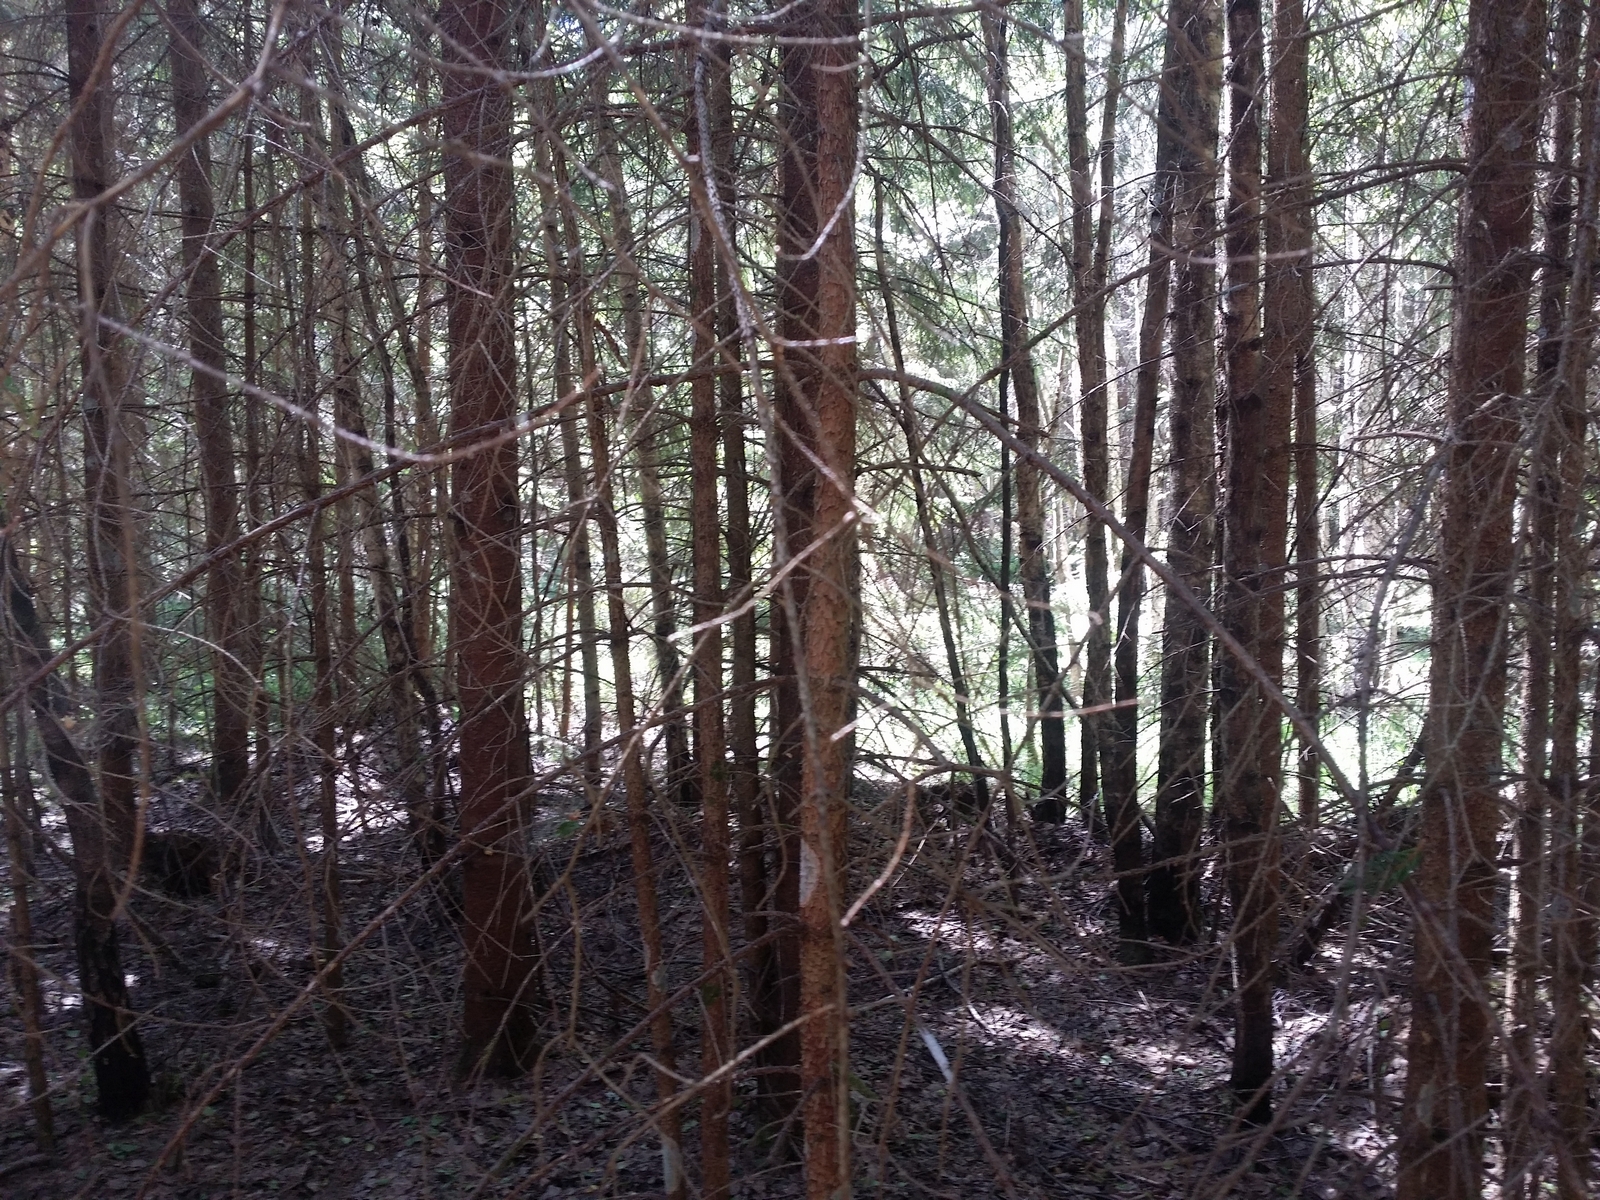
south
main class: Woodland
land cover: Spruce dominated coniferous woodland
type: hemiboreal forest and nemoral coniferous forest and mixed broadleaved-coniferous forest
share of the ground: > 75 %
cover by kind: coniferous forest trees 85 %, lichens and mosses 10 %, herbaceous plants 5 %
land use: Forestry
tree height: > 5 m
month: June
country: LV
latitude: 57.2736
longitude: 26.4108
